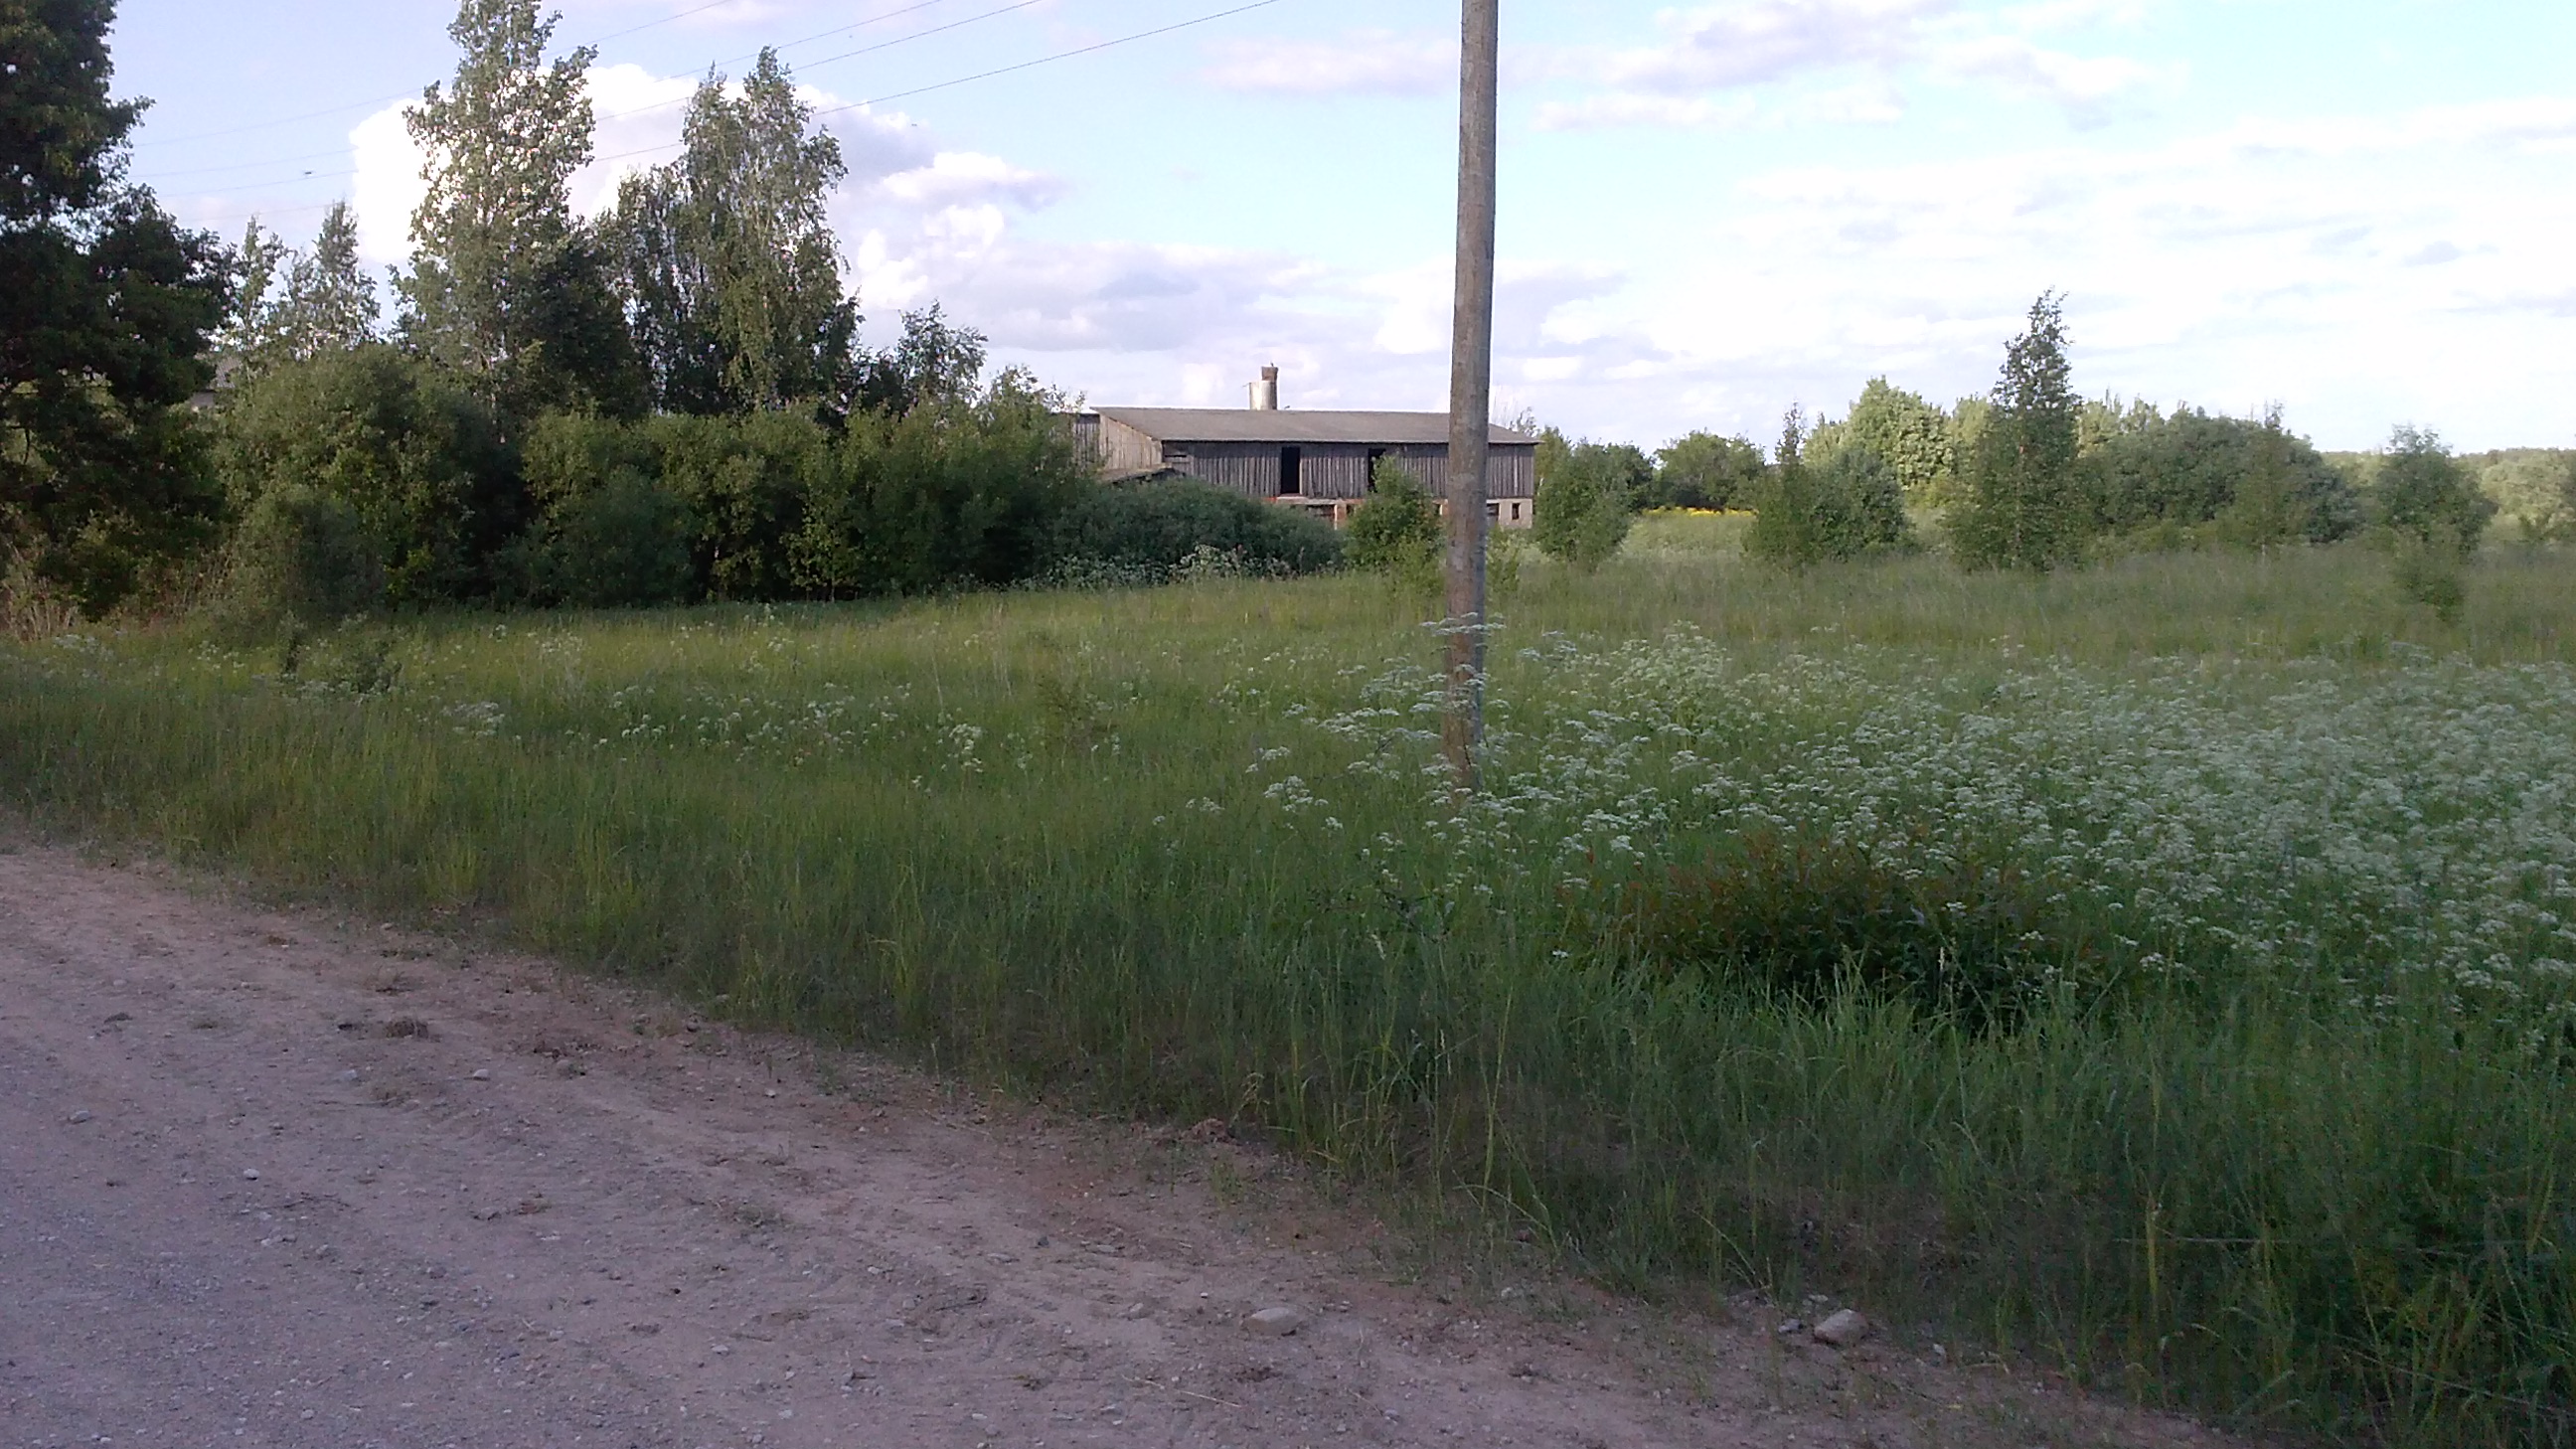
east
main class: Woodland
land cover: Broadleaved woodland
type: non-riverine alder, birch or aspen forest
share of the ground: > 75 %
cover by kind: broadleaved forest trees 100 %
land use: Forestry
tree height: > 5 m
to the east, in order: Broadleaved woodland; Grassland without tree/shrub cover; Grassland with sparse tree/shrub cover
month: June
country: LV
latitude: 56.4691
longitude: 28.0034
